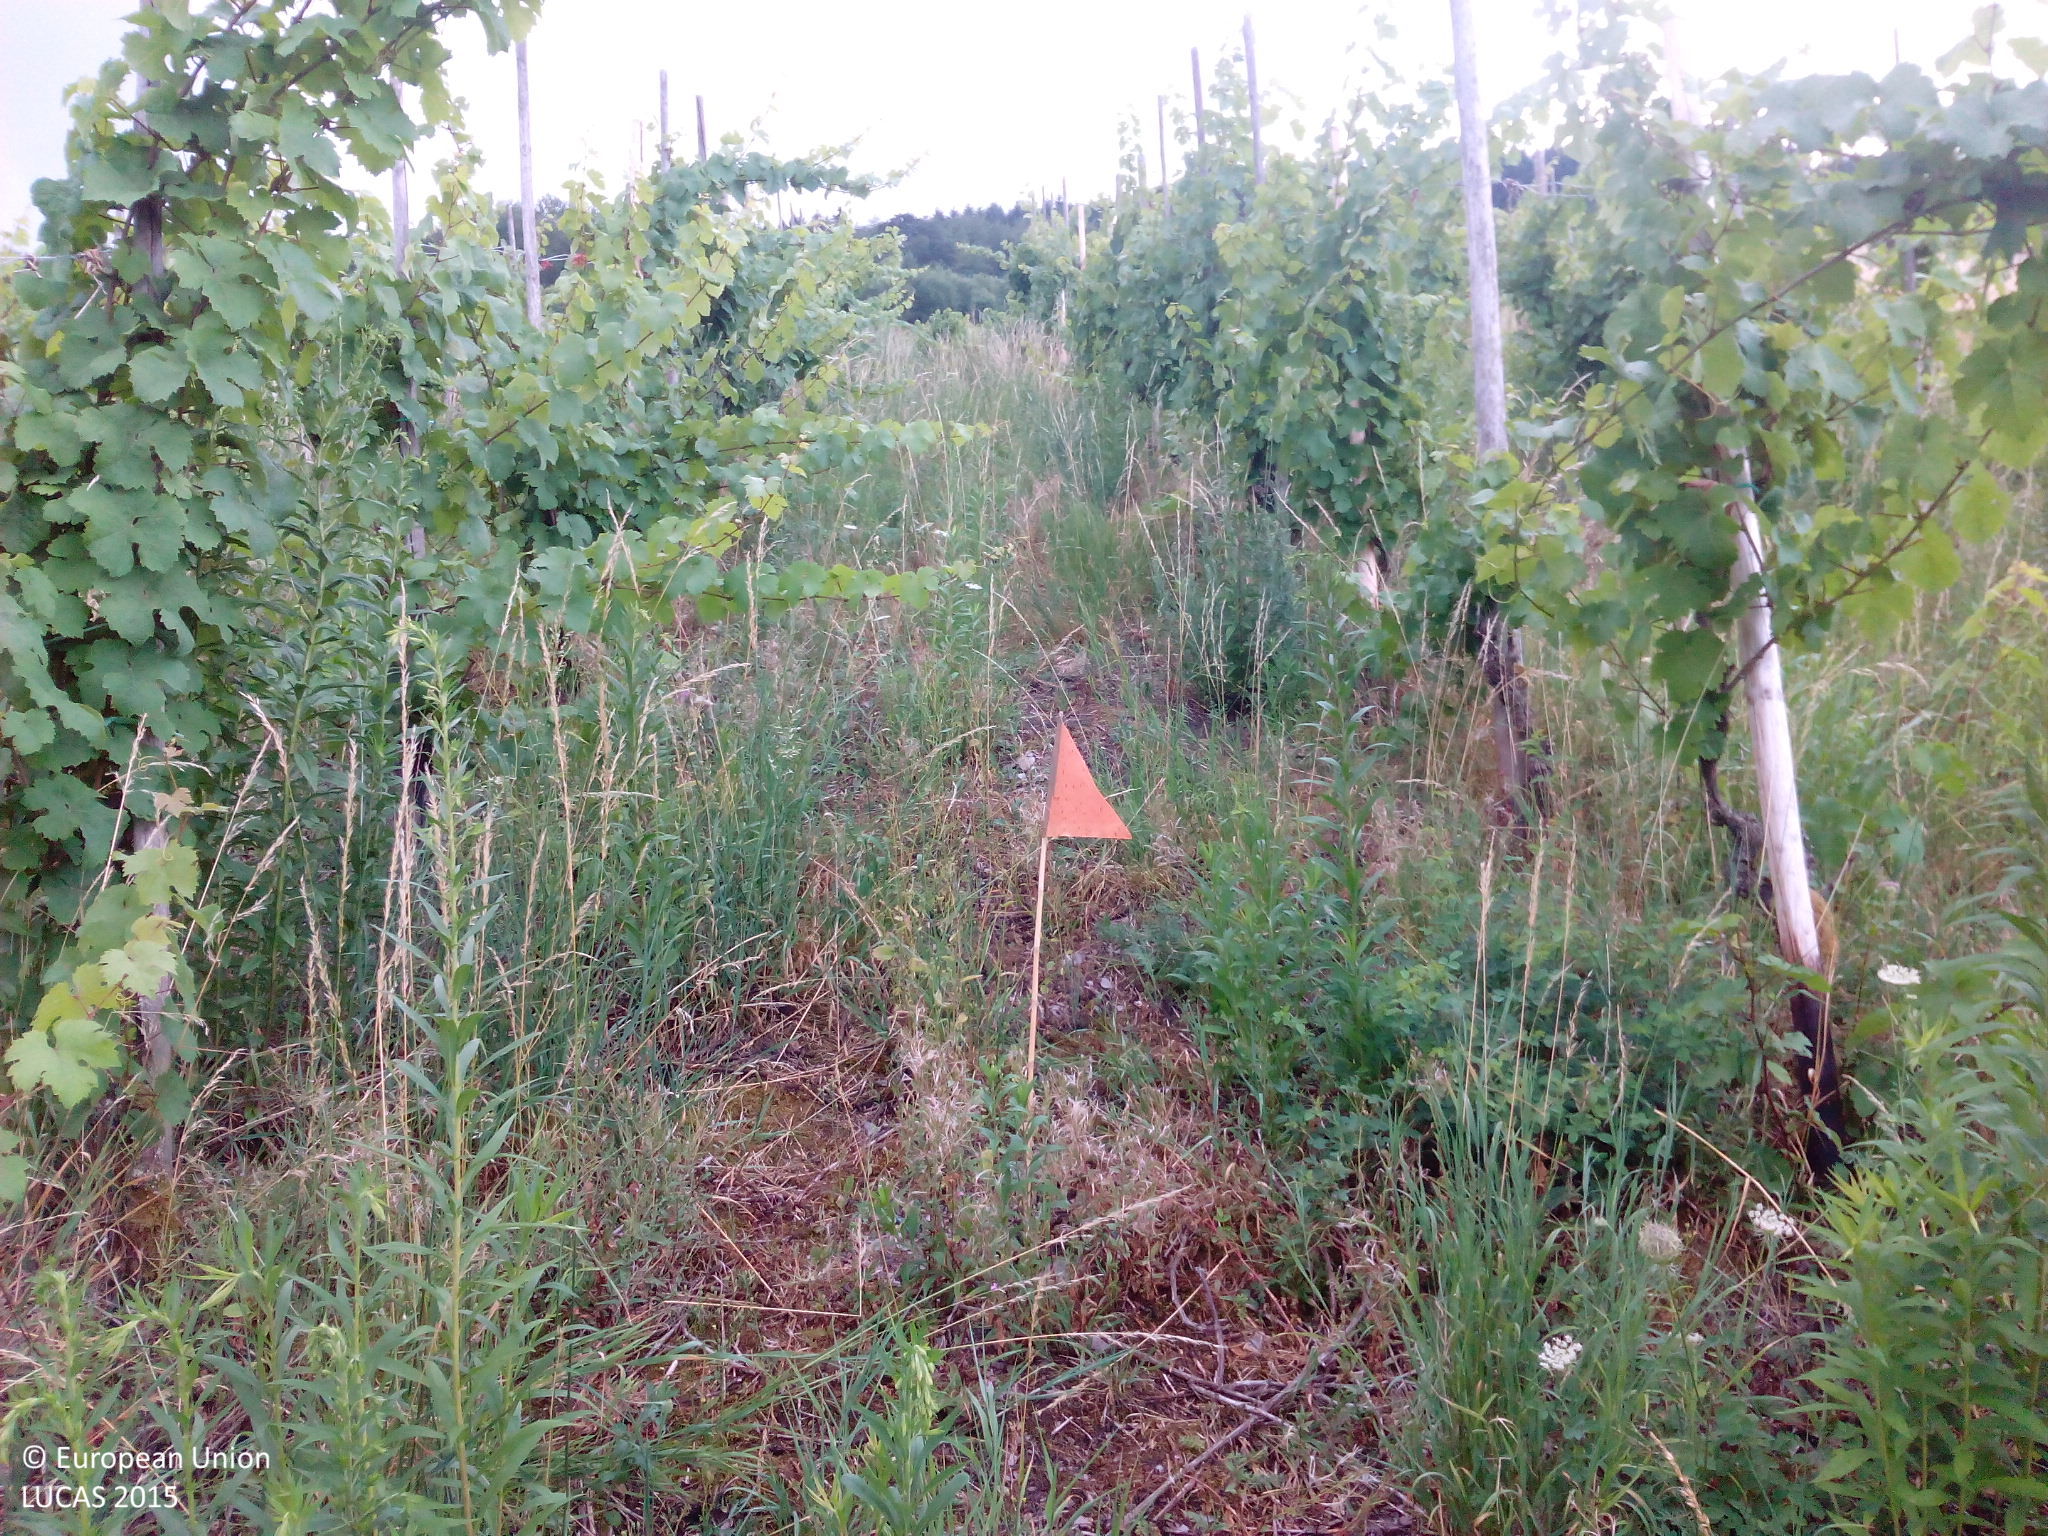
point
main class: Cropland
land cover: Vineyards
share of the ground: > 75 %
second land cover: Spontaneously vegetated surfaces
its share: > 75 %
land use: Agriculture (excluding fallow land and kitchen gardens)
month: July
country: DE
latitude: 50.0217
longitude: 7.1110
